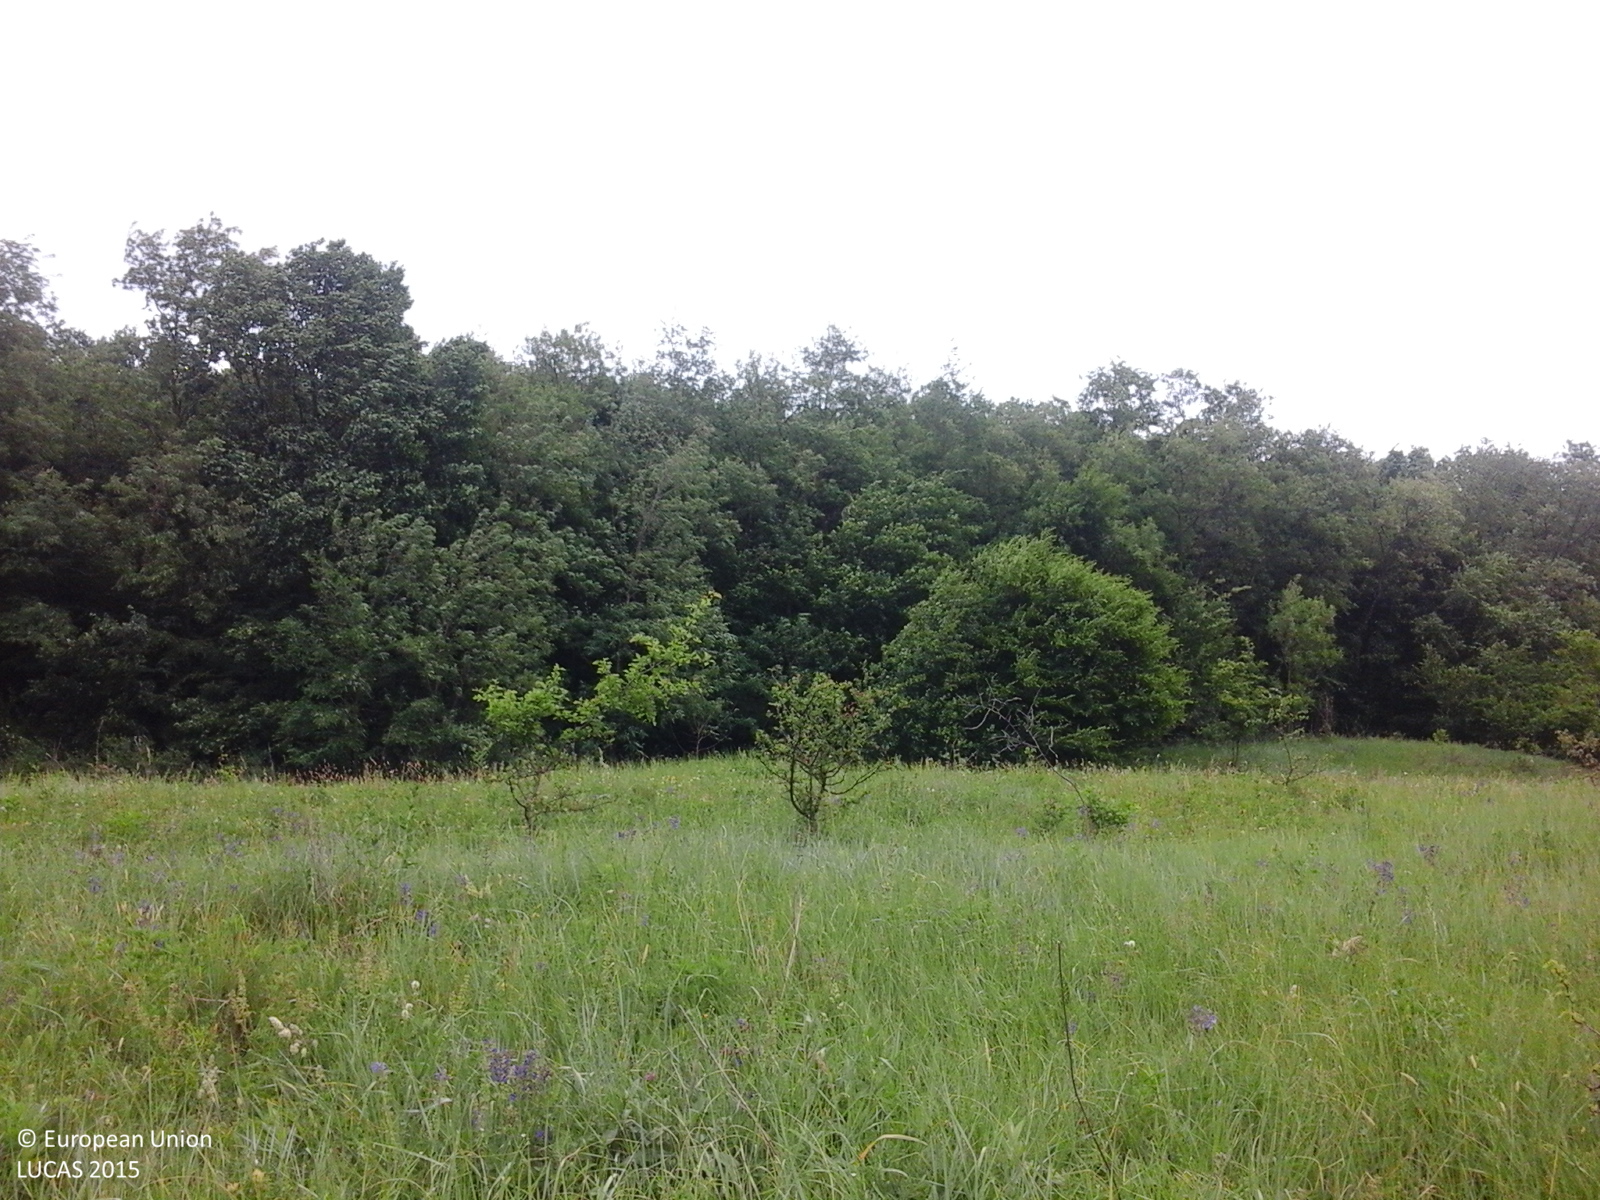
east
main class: Grassland
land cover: Grassland with sparse tree/shrub cover
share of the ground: > 75 %
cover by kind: herbaceous plants 90 %, broadleaved forest trees 5 %, shrubs 5 %
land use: Agriculture (excluding fallow land and kitchen gardens)
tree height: < 5 m
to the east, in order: Grassland with sparse tree/shrub cover; Broadleaved woodland
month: June
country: RO
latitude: 47.0144
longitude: 26.6786
